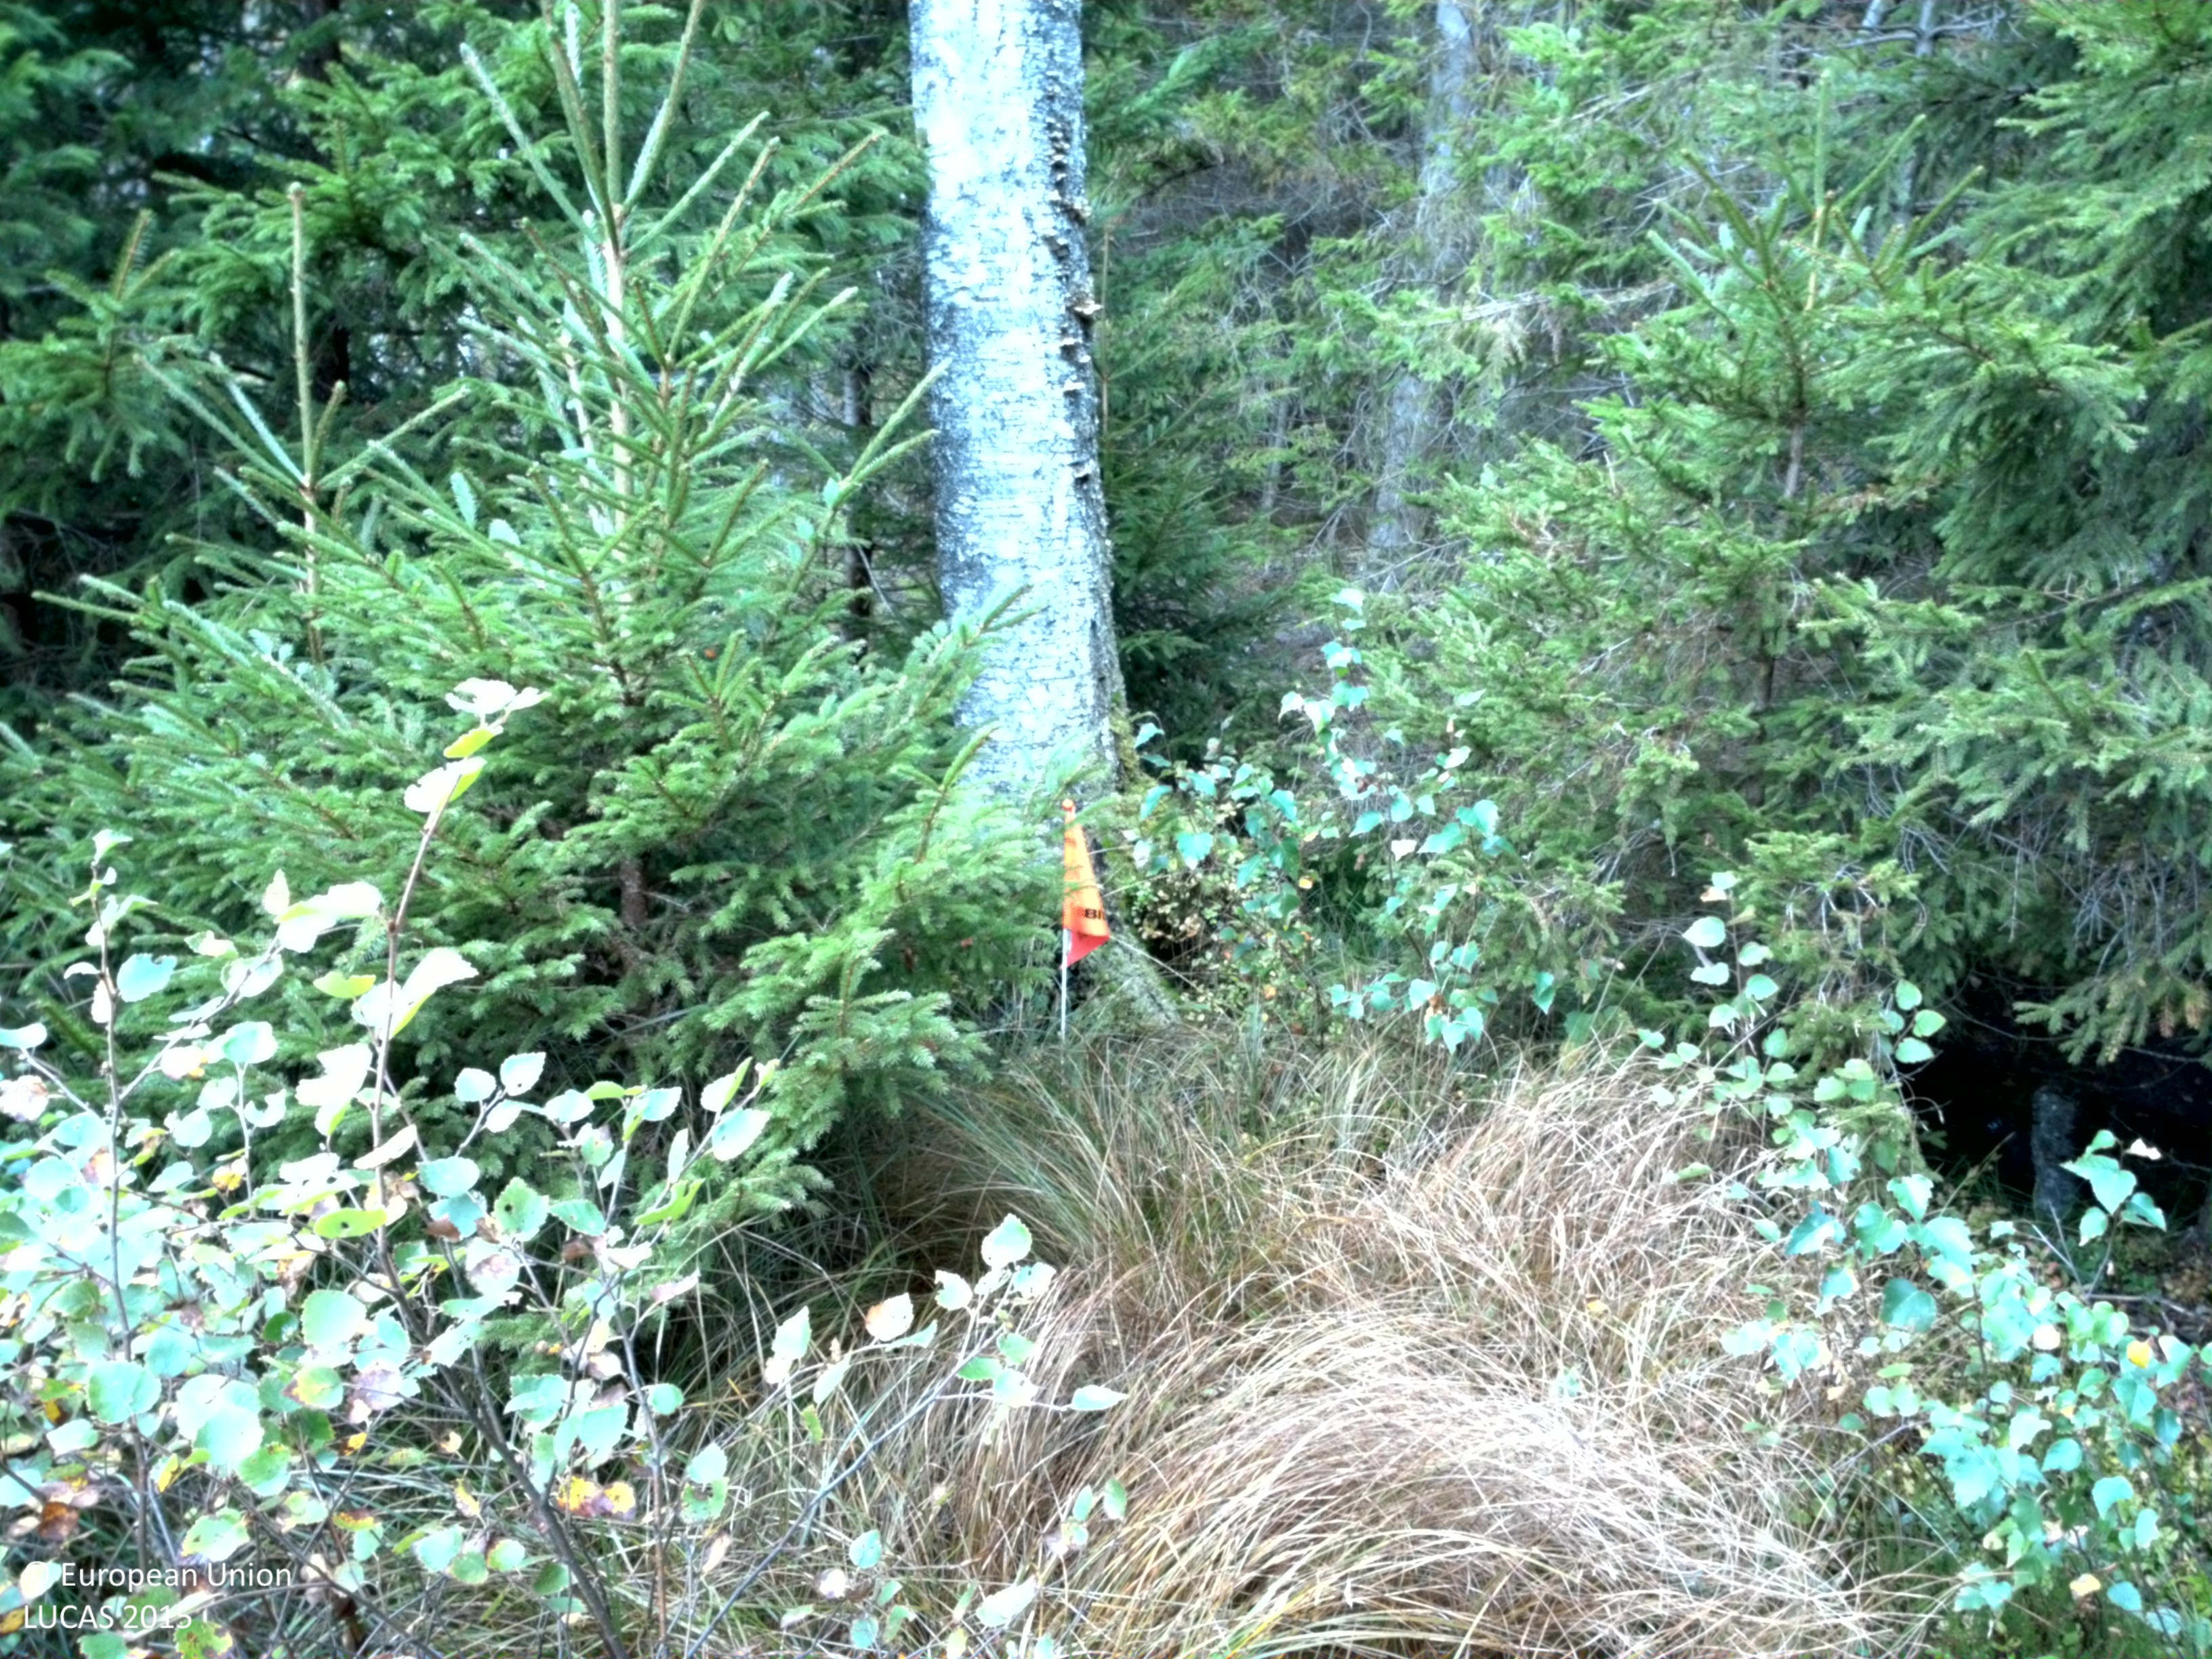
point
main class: Woodland
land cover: Spruce dominated mixed woodland
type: boreal forest
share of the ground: 25 - 50 %
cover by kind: coniferous forest trees 30 %, herbaceous plants 30 %, broadleaved forest trees 20 %, shrubs 20 %
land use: Forestry
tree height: > 5 m
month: September
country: SE
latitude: 58.1305
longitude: 13.0684
